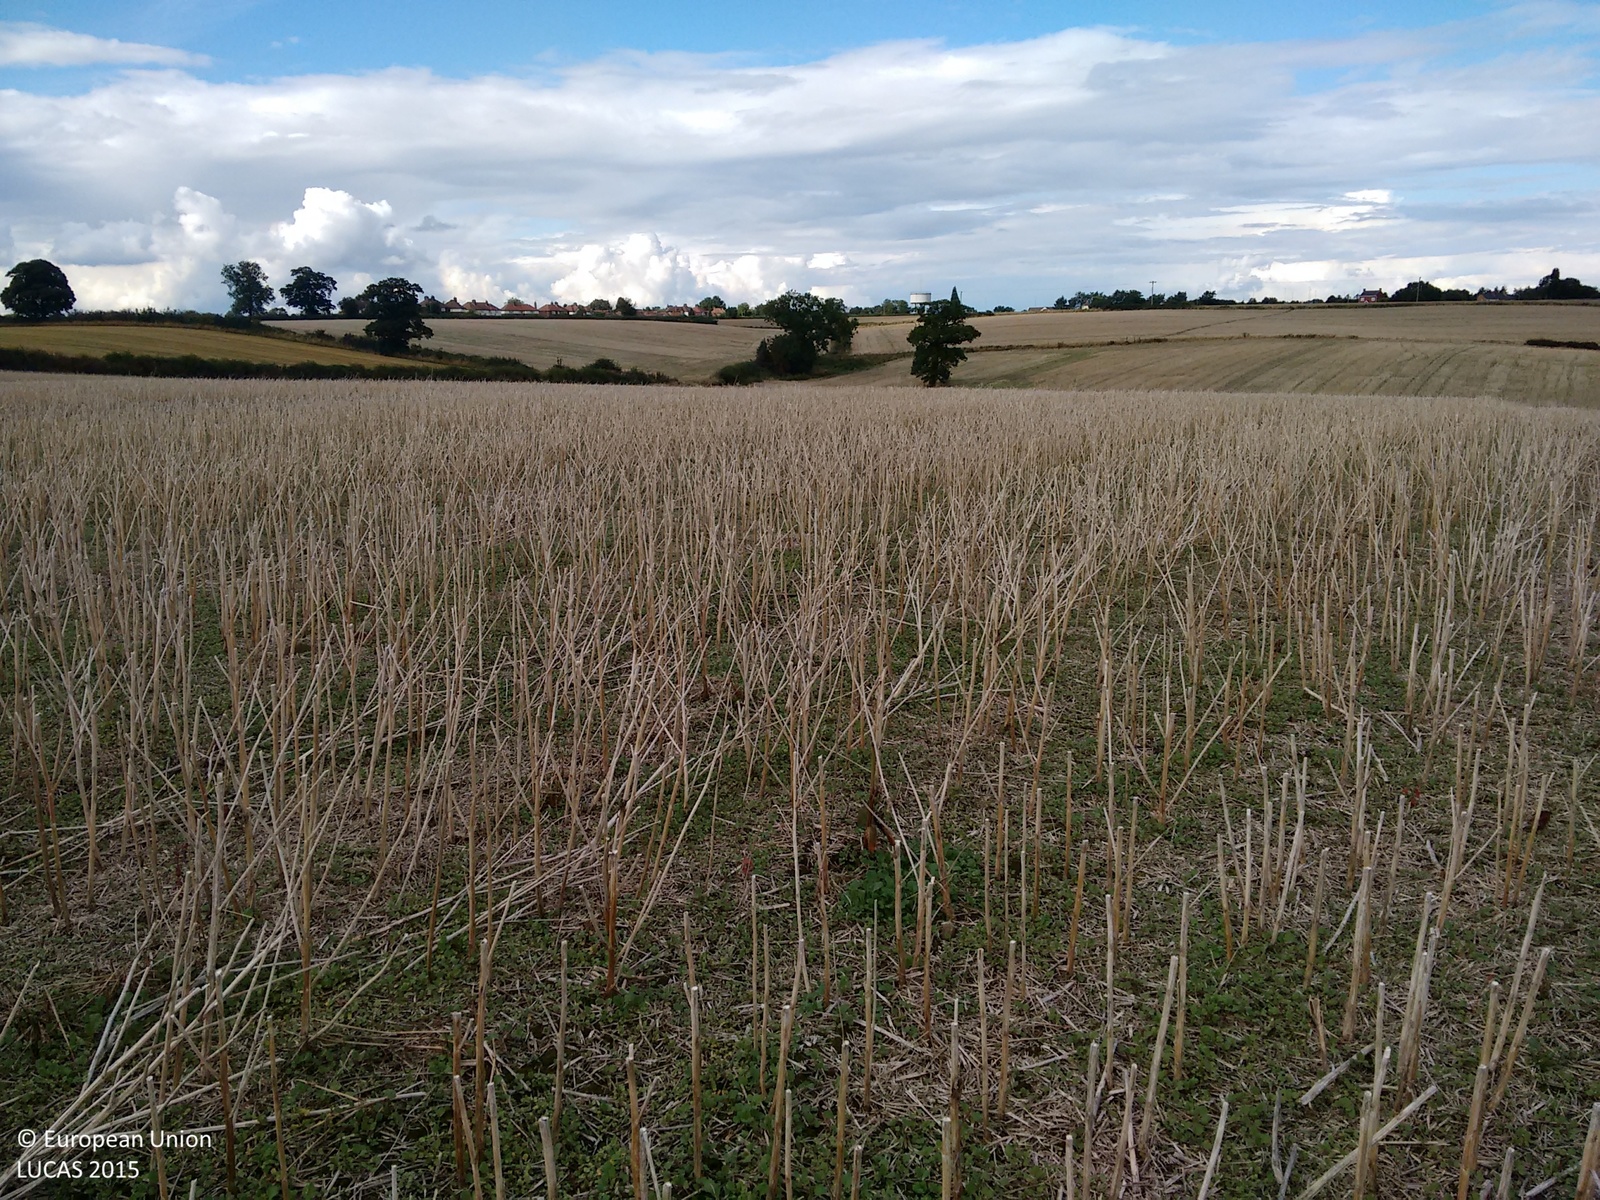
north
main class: Cropland
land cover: Rape and turnip rape
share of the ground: > 75 %
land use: Agriculture (excluding fallow land and kitchen gardens)
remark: Harvested field
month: September
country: GB
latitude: 52.7606
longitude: -1.5057
